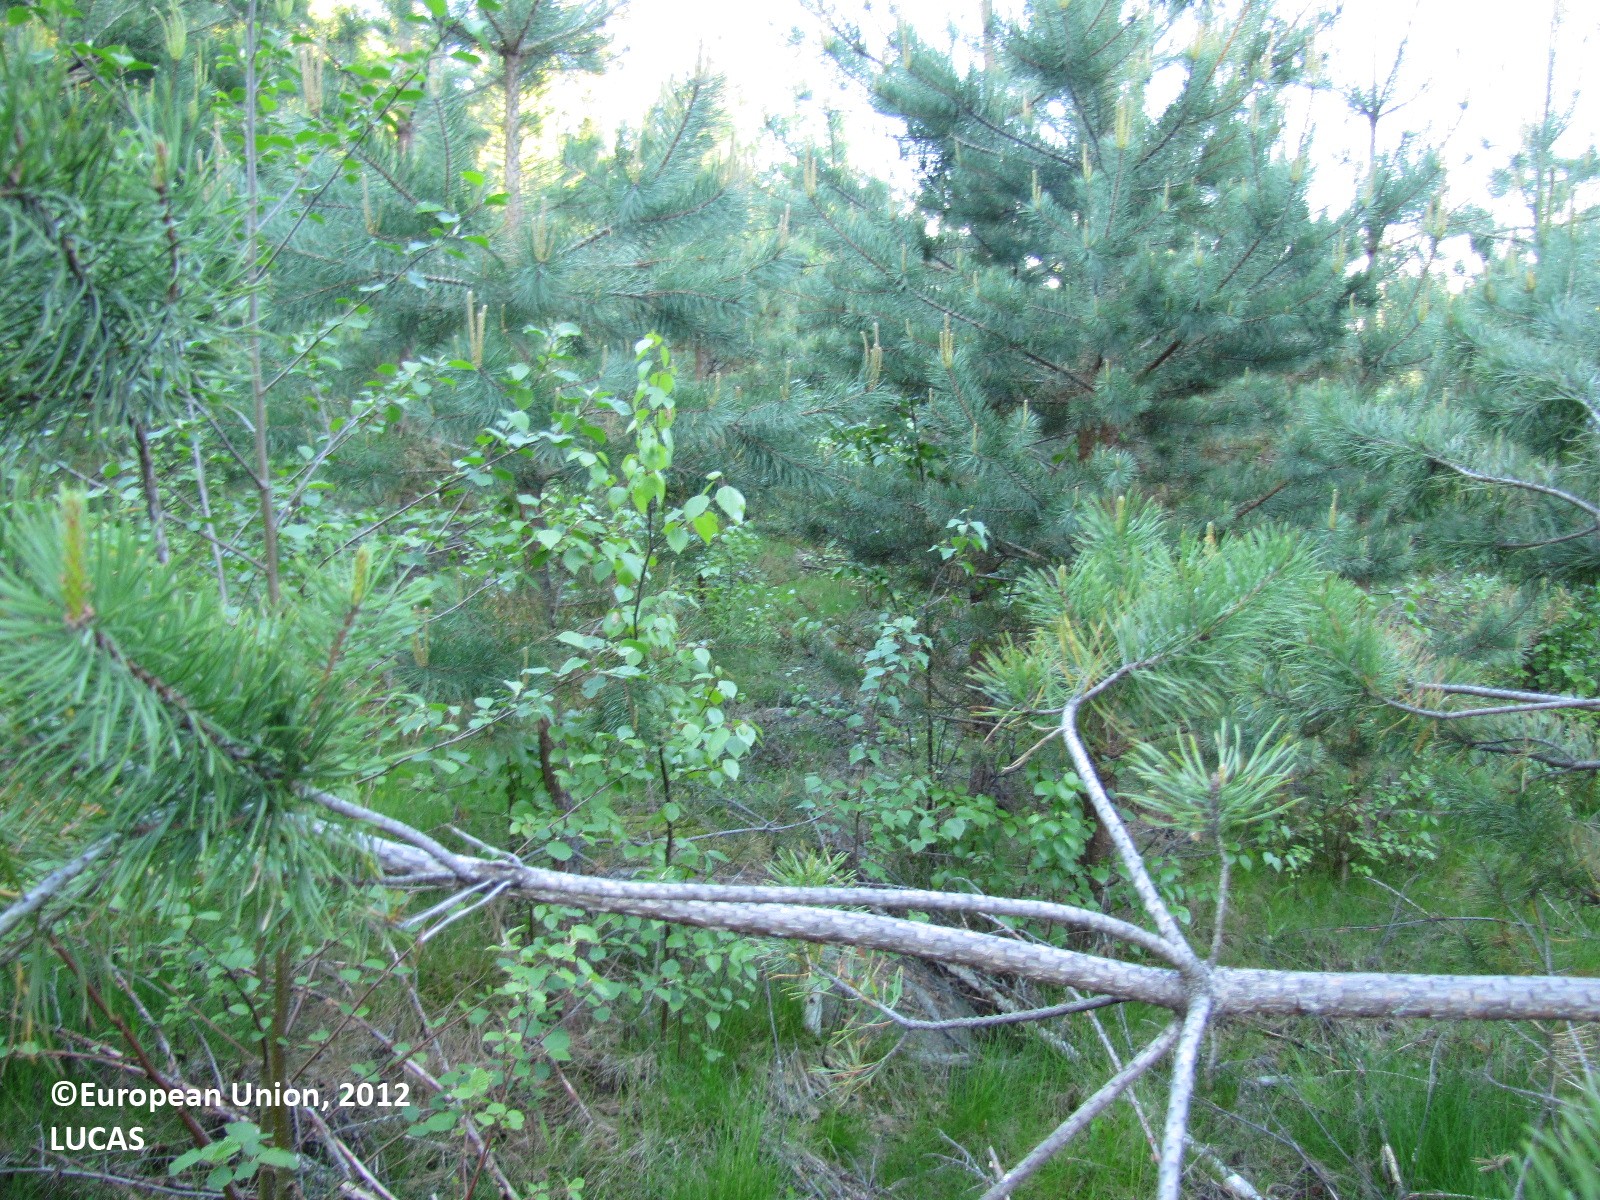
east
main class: Woodland
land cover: Pine dominated mixed woodland
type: boreal forest
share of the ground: 25 - 50 %
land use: Forestry
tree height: < 5 m
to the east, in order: Pine dominated mixed woodland; Ditches and canals; Grass margins; Tracks; Grass margins; Ditches and canals; Abandoned hedges; Spruce dominated coniferous woodland
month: June
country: FI
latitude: 61.2337
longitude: 22.8682
